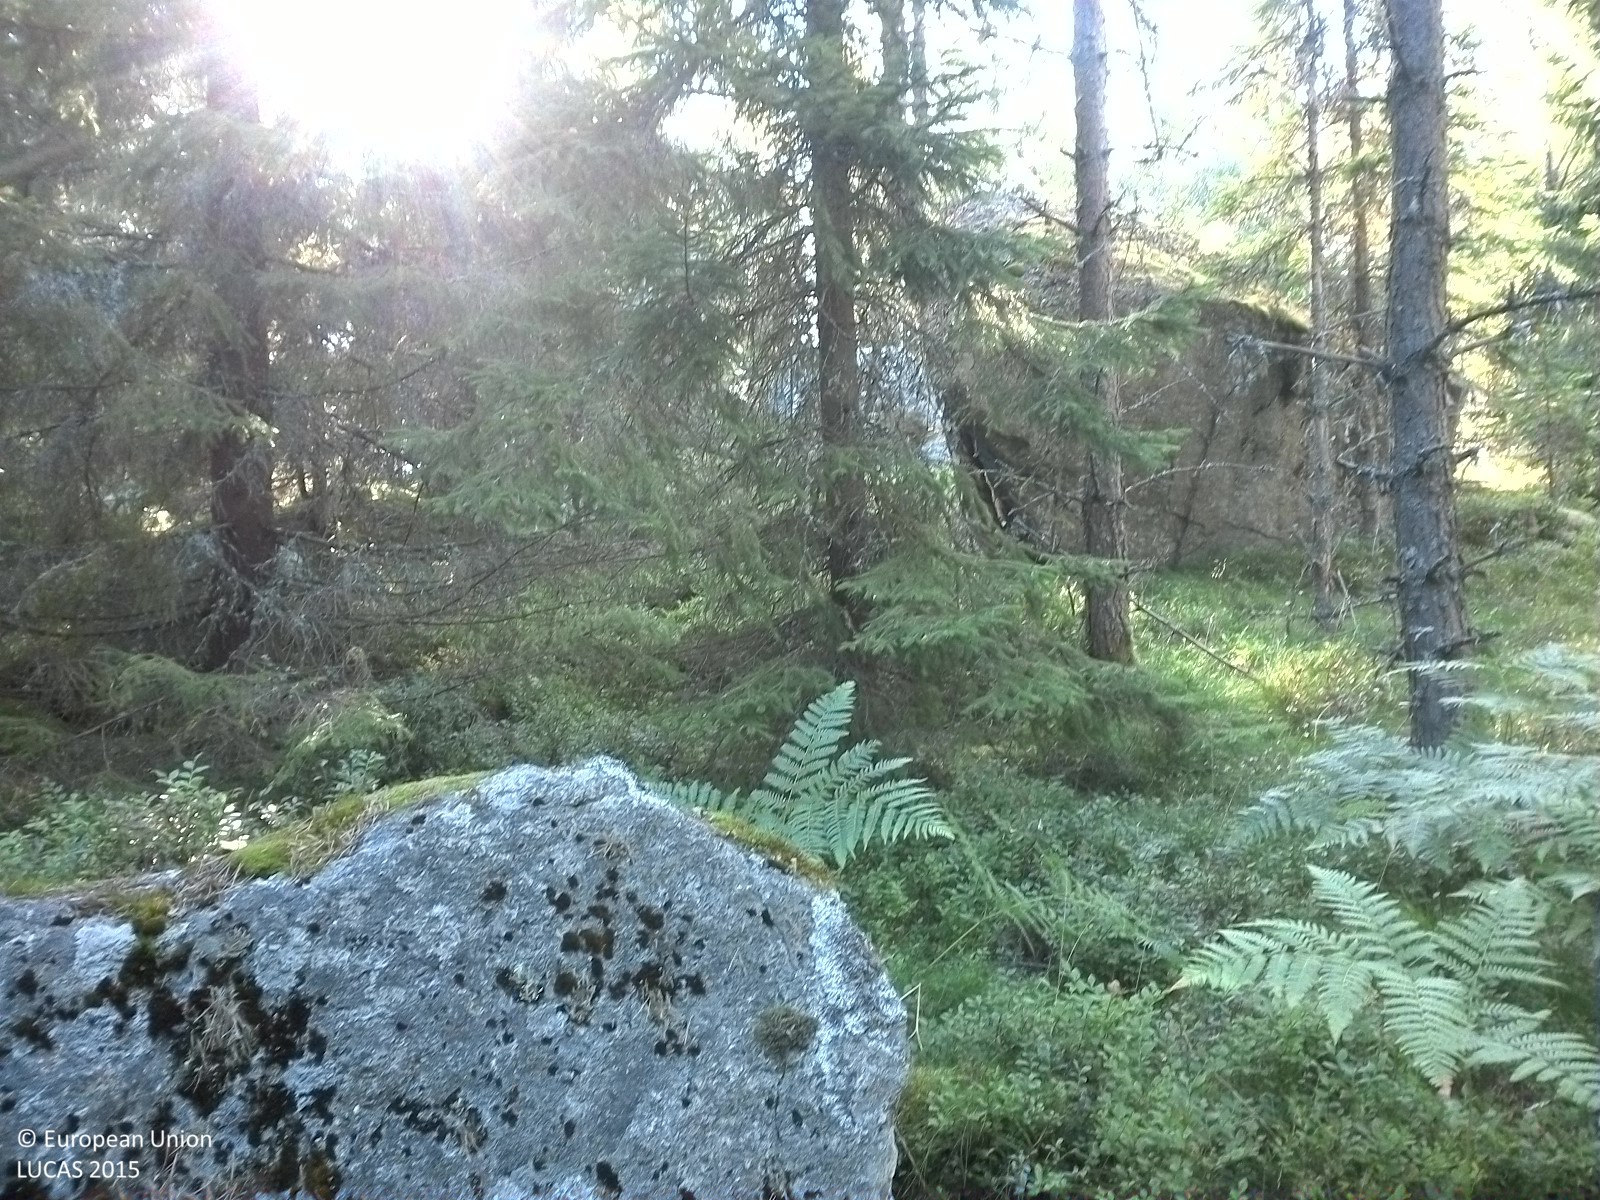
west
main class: Woodland
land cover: Other coniferous woodland
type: boreal forest
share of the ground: 25 - 50 %
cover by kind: herbaceous plants 45 %, coniferous forest trees 40 %, lichens and mosses 15 %
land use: Forestry
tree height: > 5 m
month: August
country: SE
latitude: 59.2199
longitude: 14.6693
